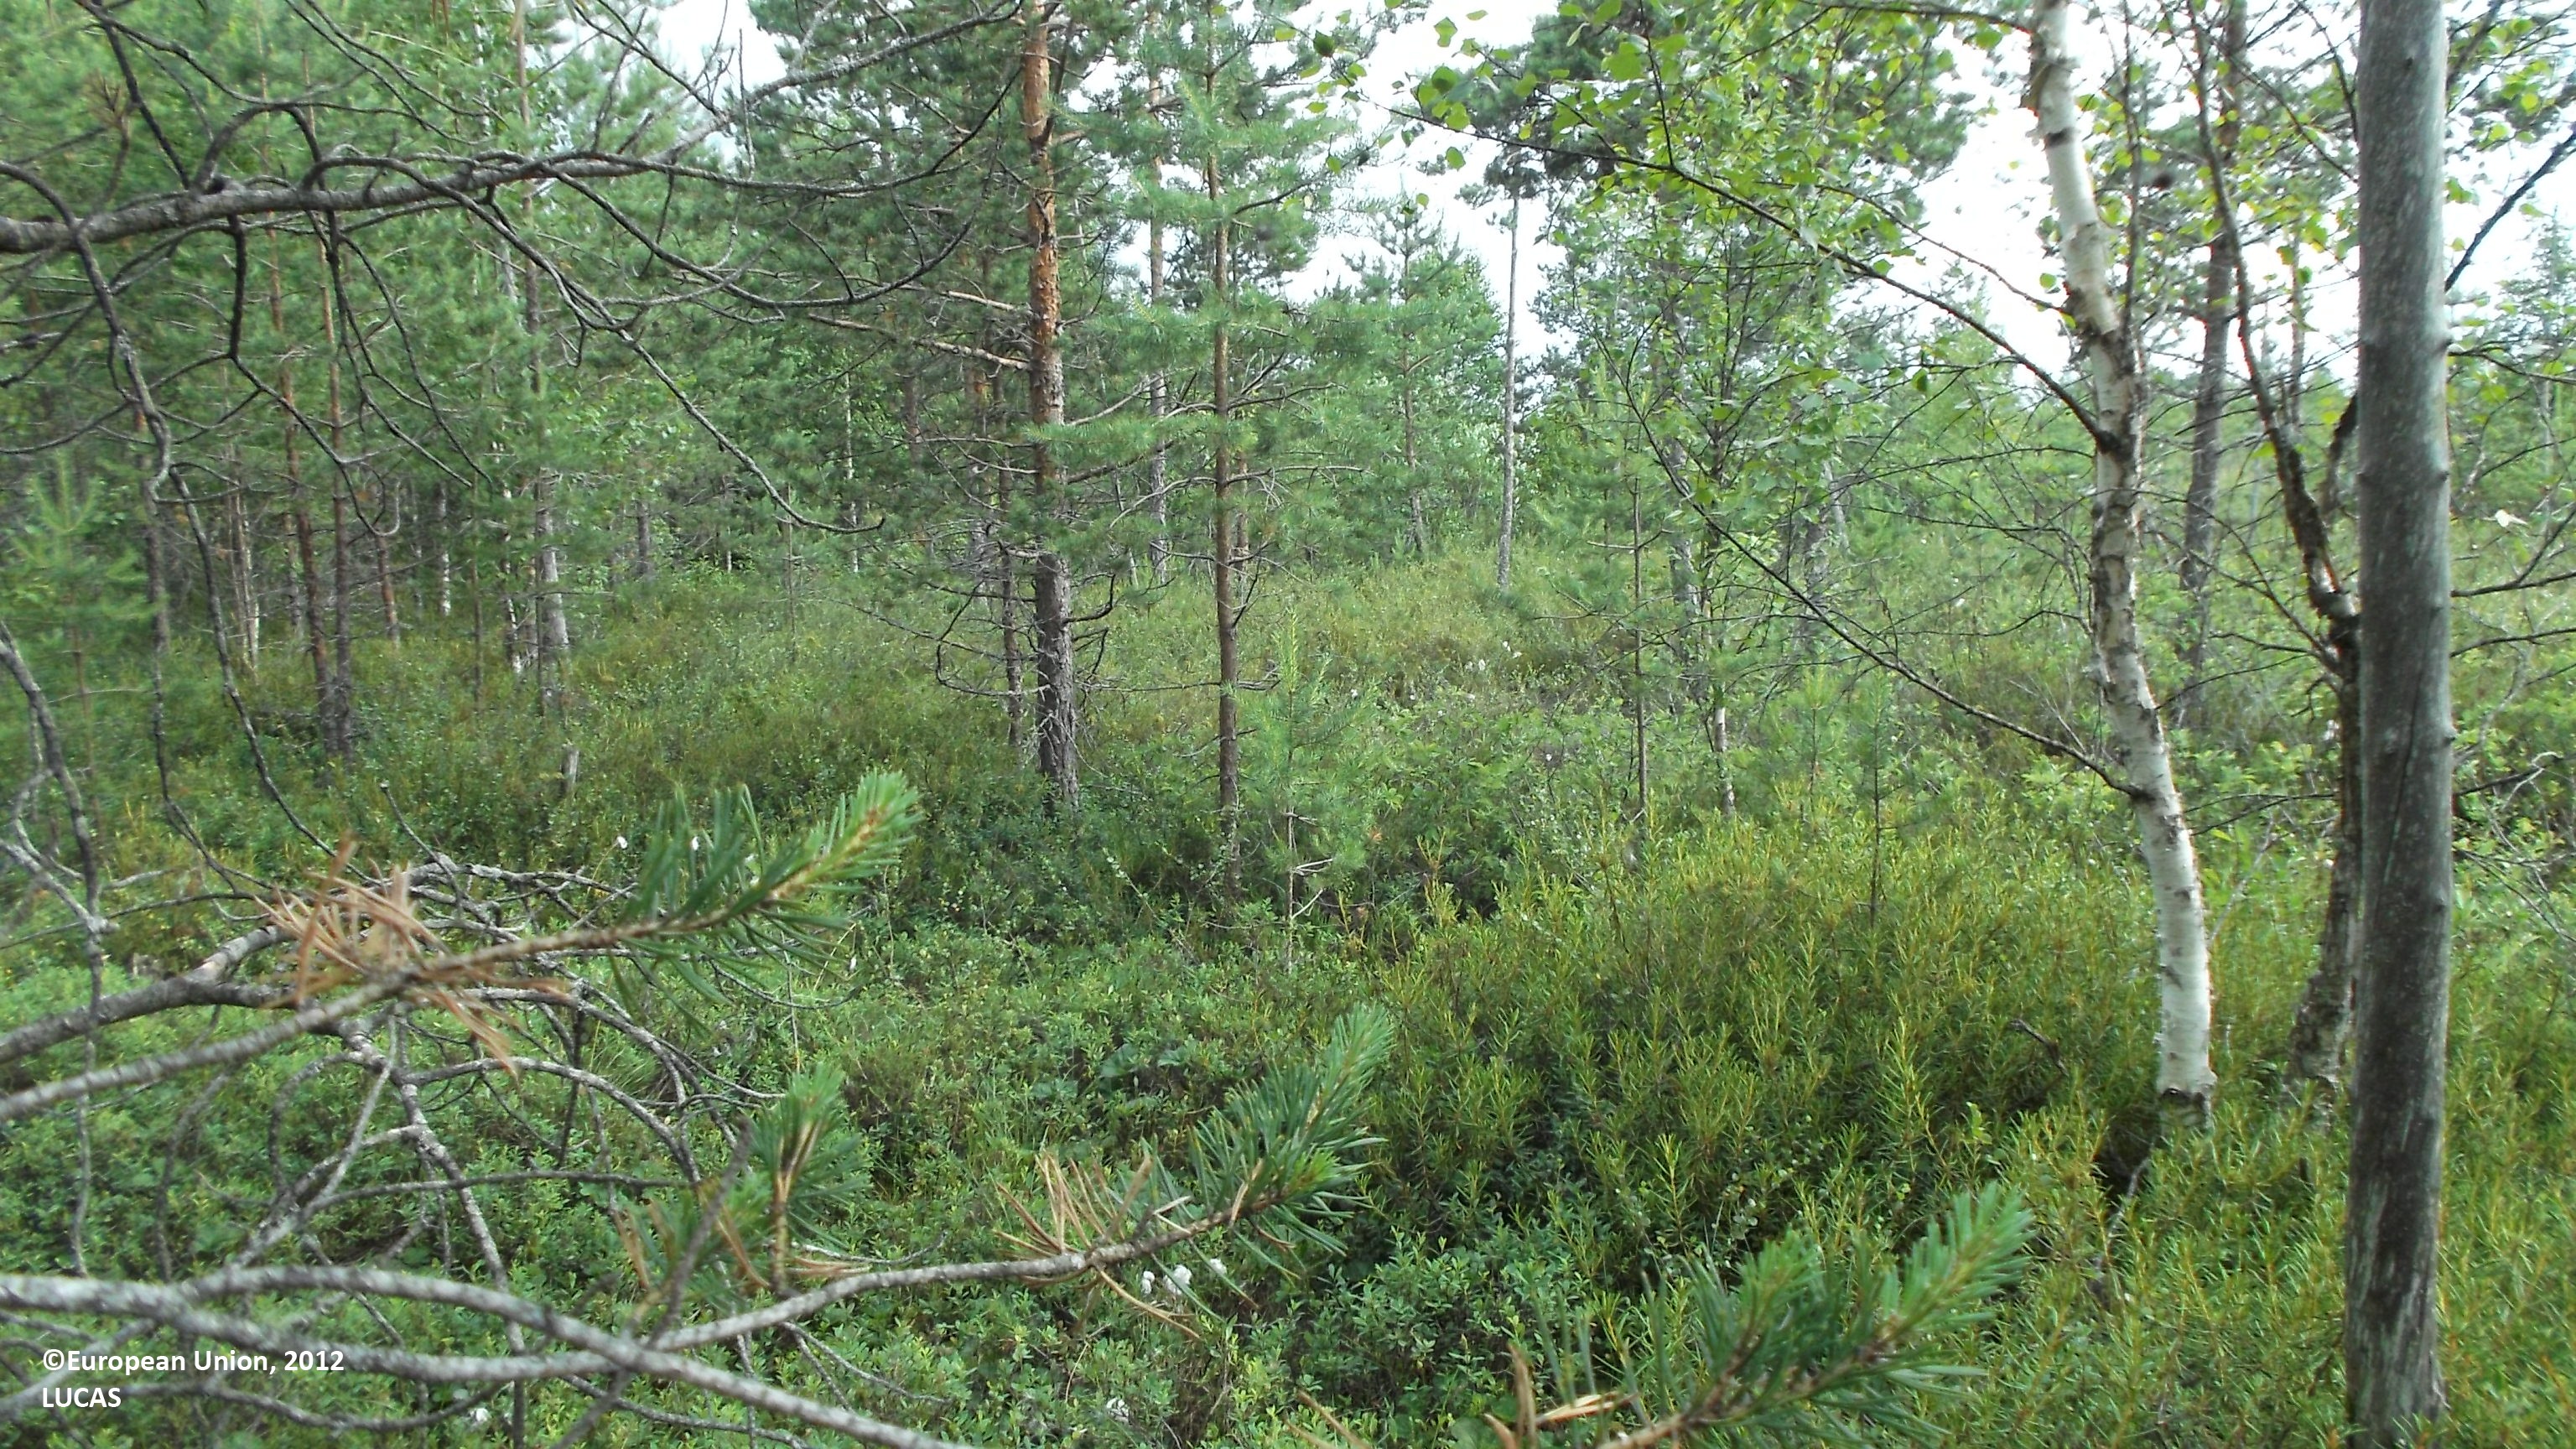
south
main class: Woodland
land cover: Pine dominated coniferous woodland
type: mire and swamp forests
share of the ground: 25 - 50 %
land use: Forestry
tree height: > 5 m
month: July
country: FI
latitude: 63.5901
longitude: 23.9941
